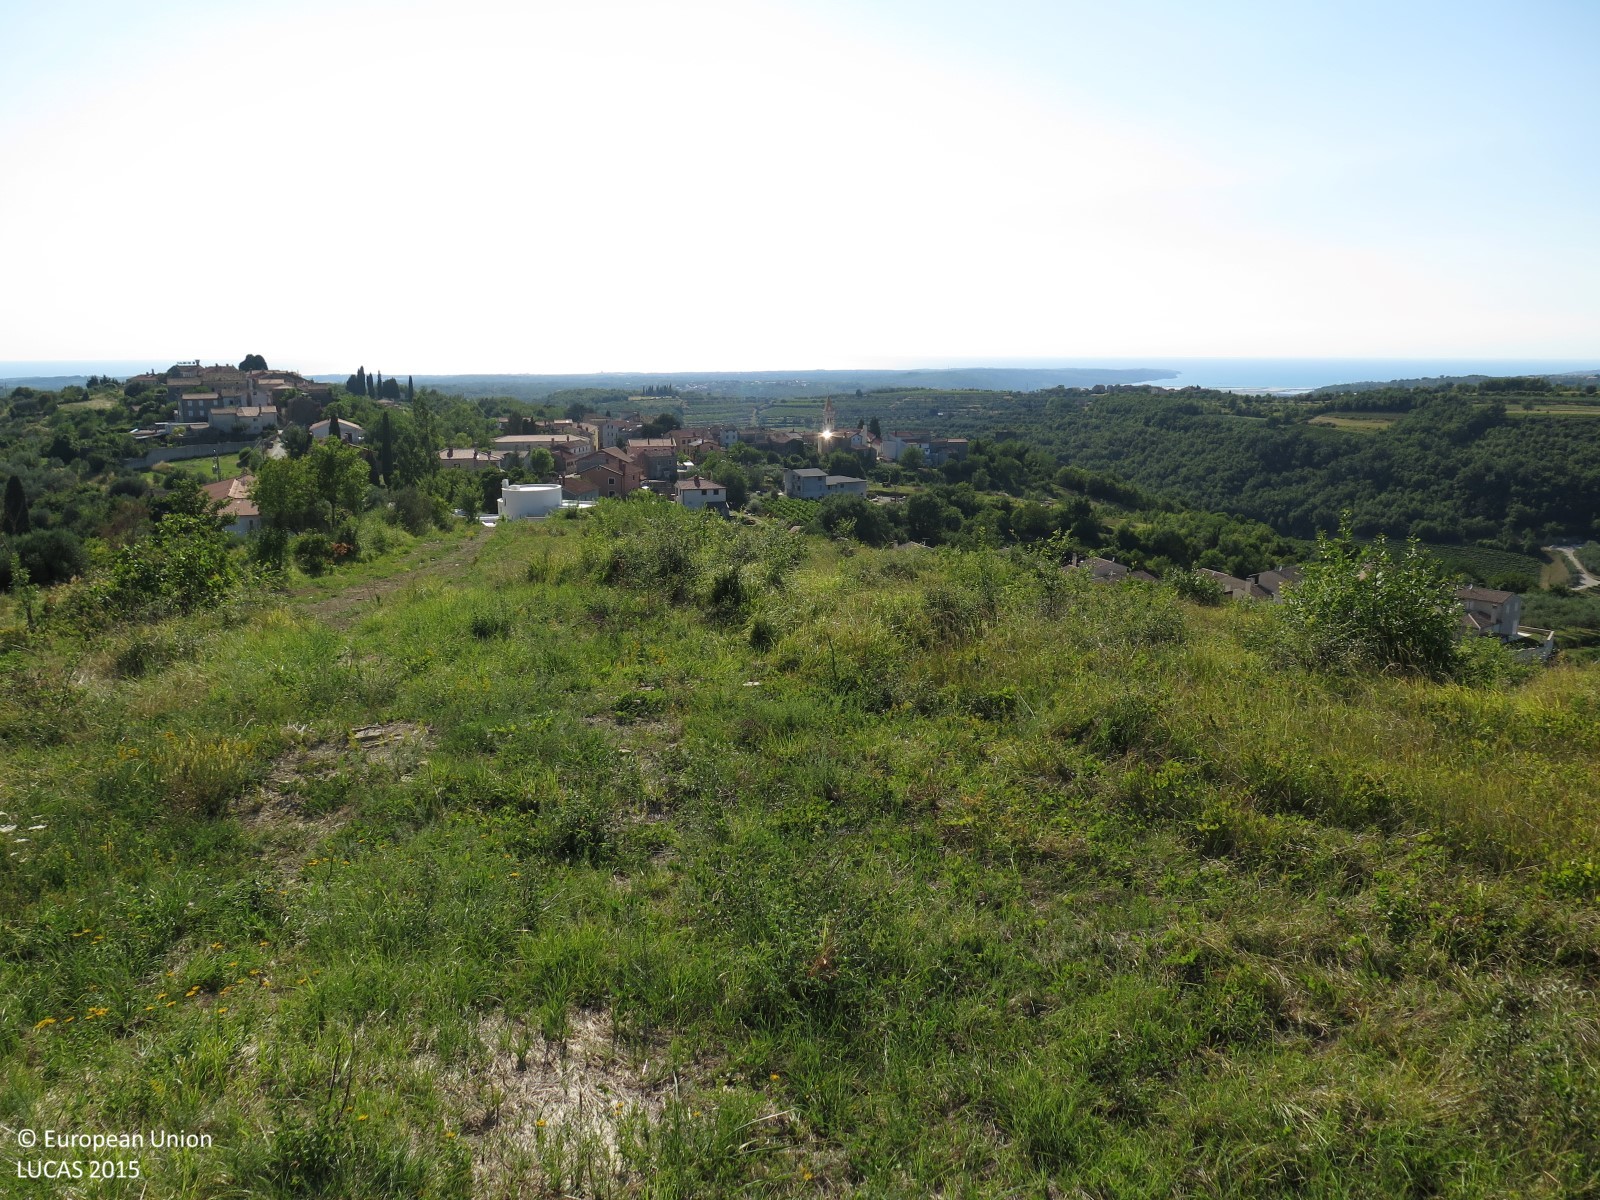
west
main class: Grassland
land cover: Grassland with sparse tree/shrub cover
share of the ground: 50 - 75 %
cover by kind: herbaceous plants 90 %, coniferous forest trees 5 %, shrubs 5 %
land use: Abandoned areas
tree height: < 5 m
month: July
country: HR
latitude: 45.4391
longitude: 13.7153
